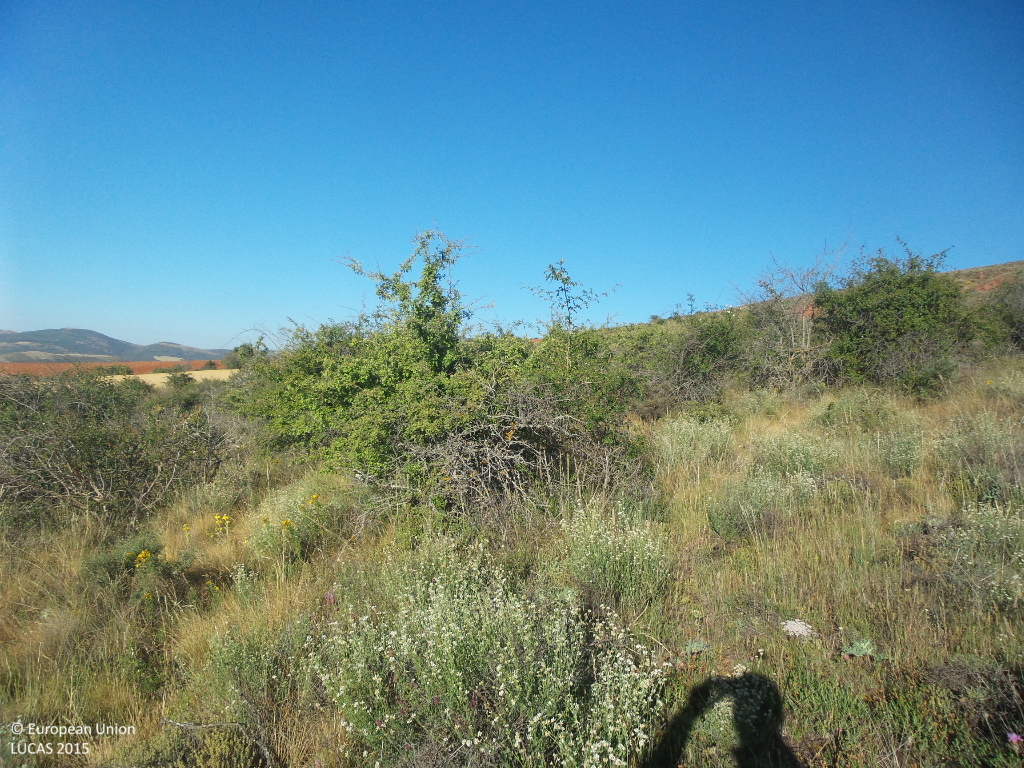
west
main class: Shrubland
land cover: Shrubland without tree cover
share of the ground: > 75 %
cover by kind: shrubs 80 %, herbaceous plants 10 %, unconsolidated bare surface 10 %
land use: Semi-natural and natural areas not in use
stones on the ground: < 10 %
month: June
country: ES
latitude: 41.2182
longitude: -2.9315
